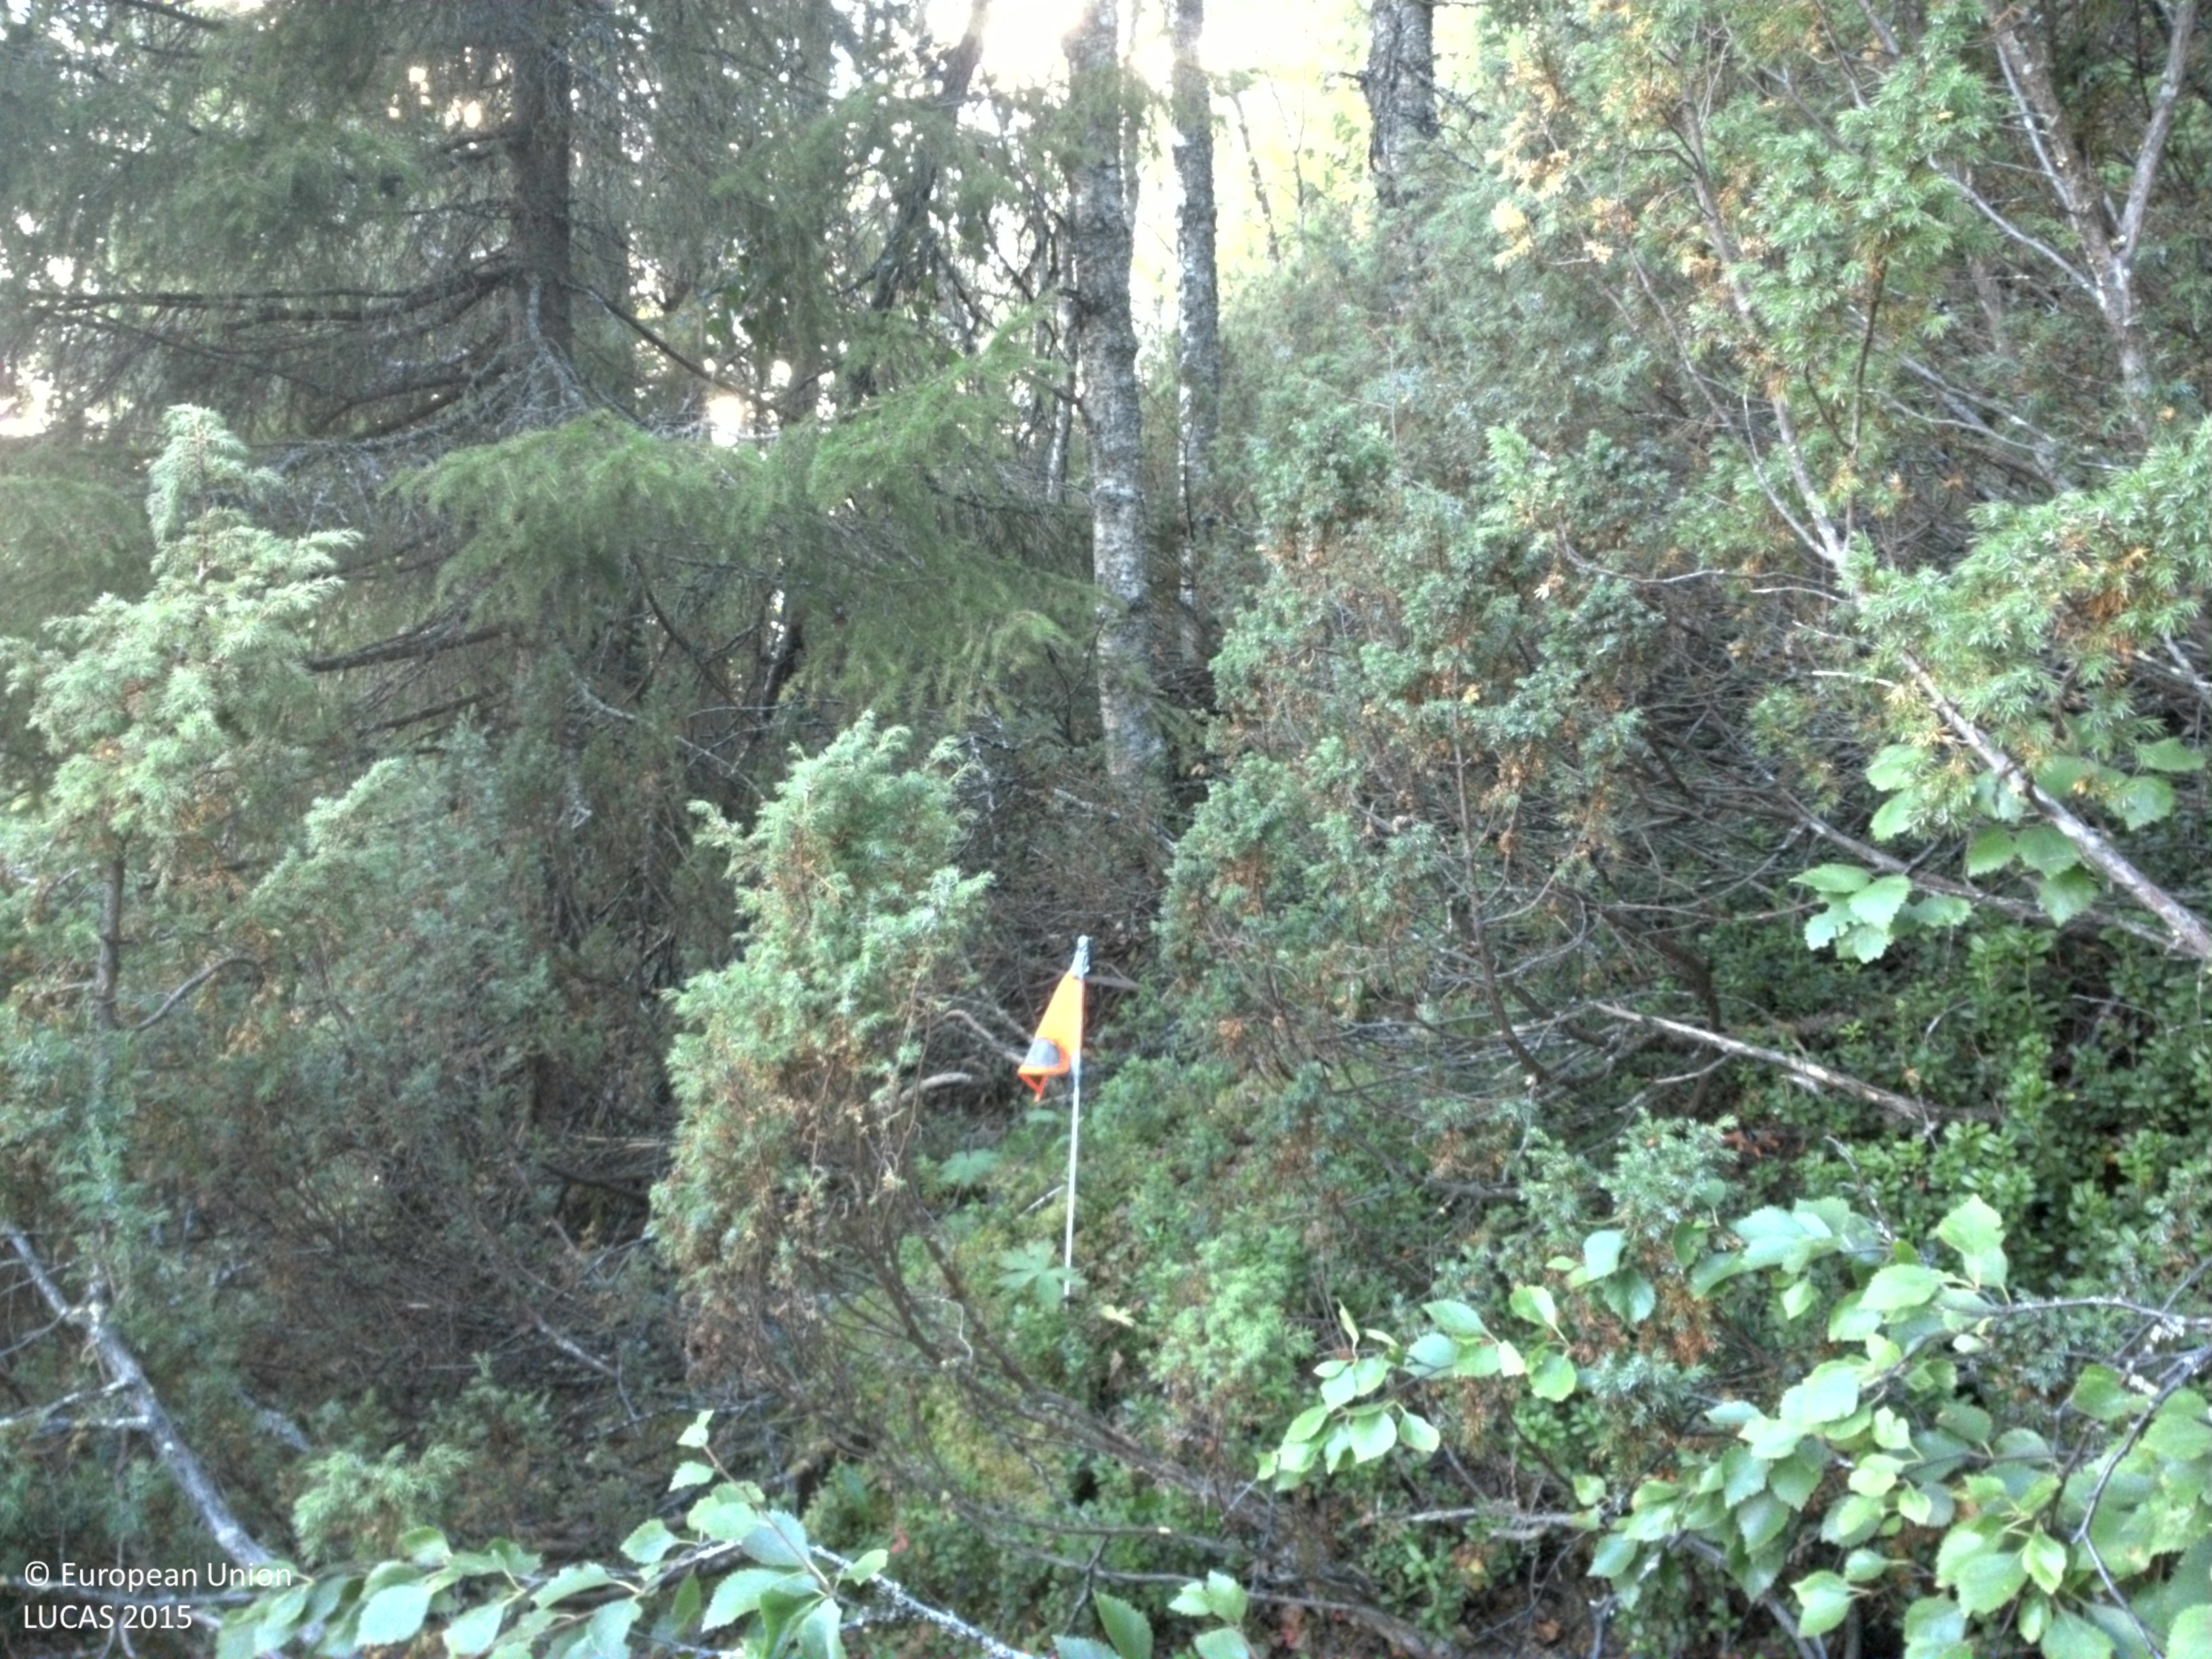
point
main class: Woodland
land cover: Spruce dominated mixed woodland
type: boreal forest
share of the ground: 25 - 50 %
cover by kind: shrubs 50 %, broadleaved forest trees 25 %, coniferous forest trees 20 %, lichens and mosses 5 %
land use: Forestry
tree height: > 5 m
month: September
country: SE
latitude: 64.9716
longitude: 16.5108
